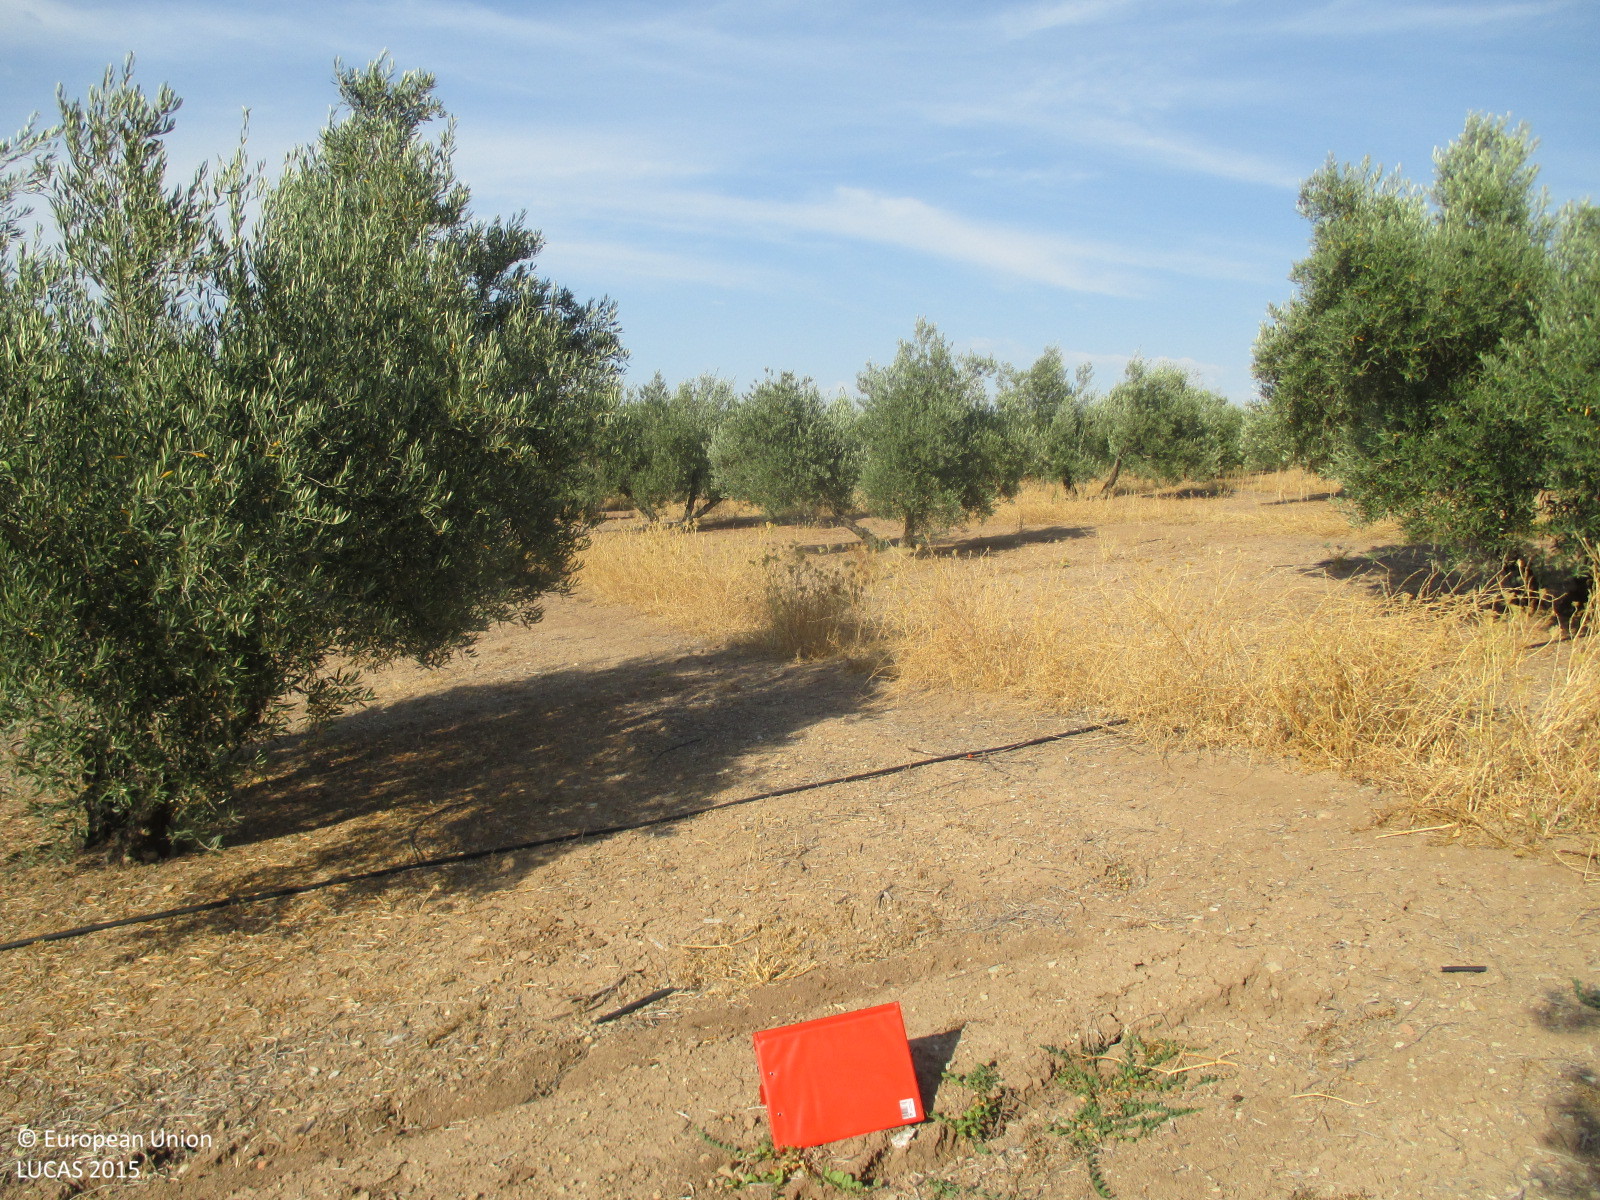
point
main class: Cropland
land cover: Olive groves
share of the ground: 25 - 50 %
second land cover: Other bare soil
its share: > 75 %
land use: Agriculture (excluding fallow land and kitchen gardens)
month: June
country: ES
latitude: 37.6237
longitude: -4.1308
